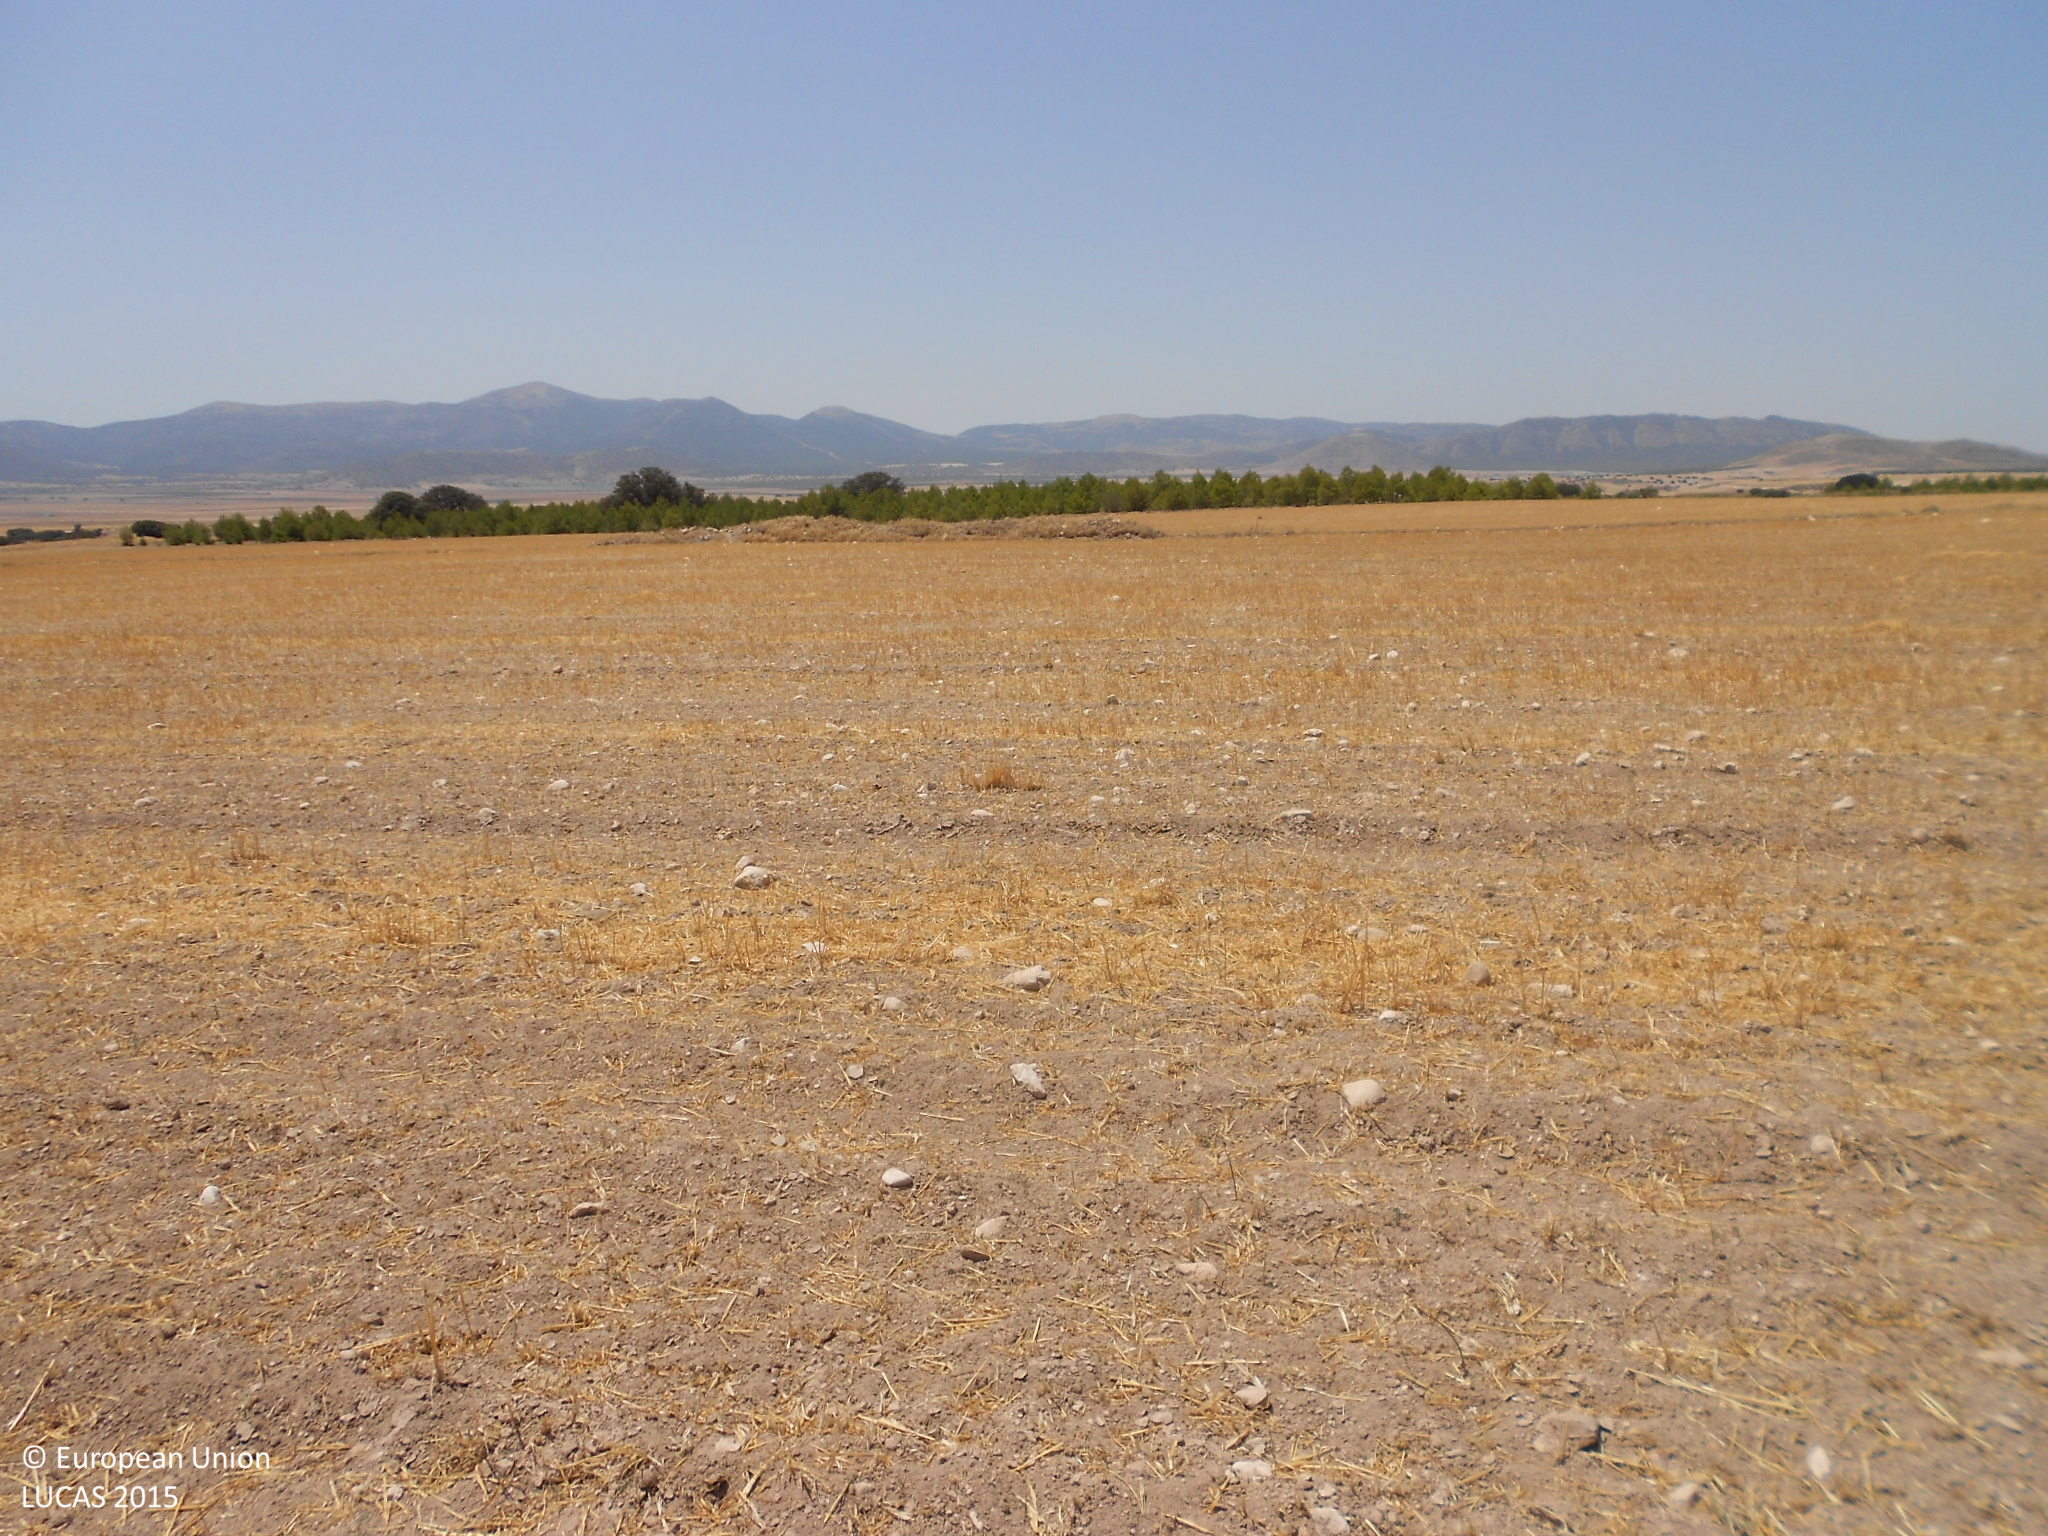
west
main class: Cropland
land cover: Oats
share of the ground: < 10 %
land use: Agriculture (excluding fallow land and kitchen gardens)
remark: Harvested field
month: August
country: ES
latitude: 37.7308
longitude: -2.3209
